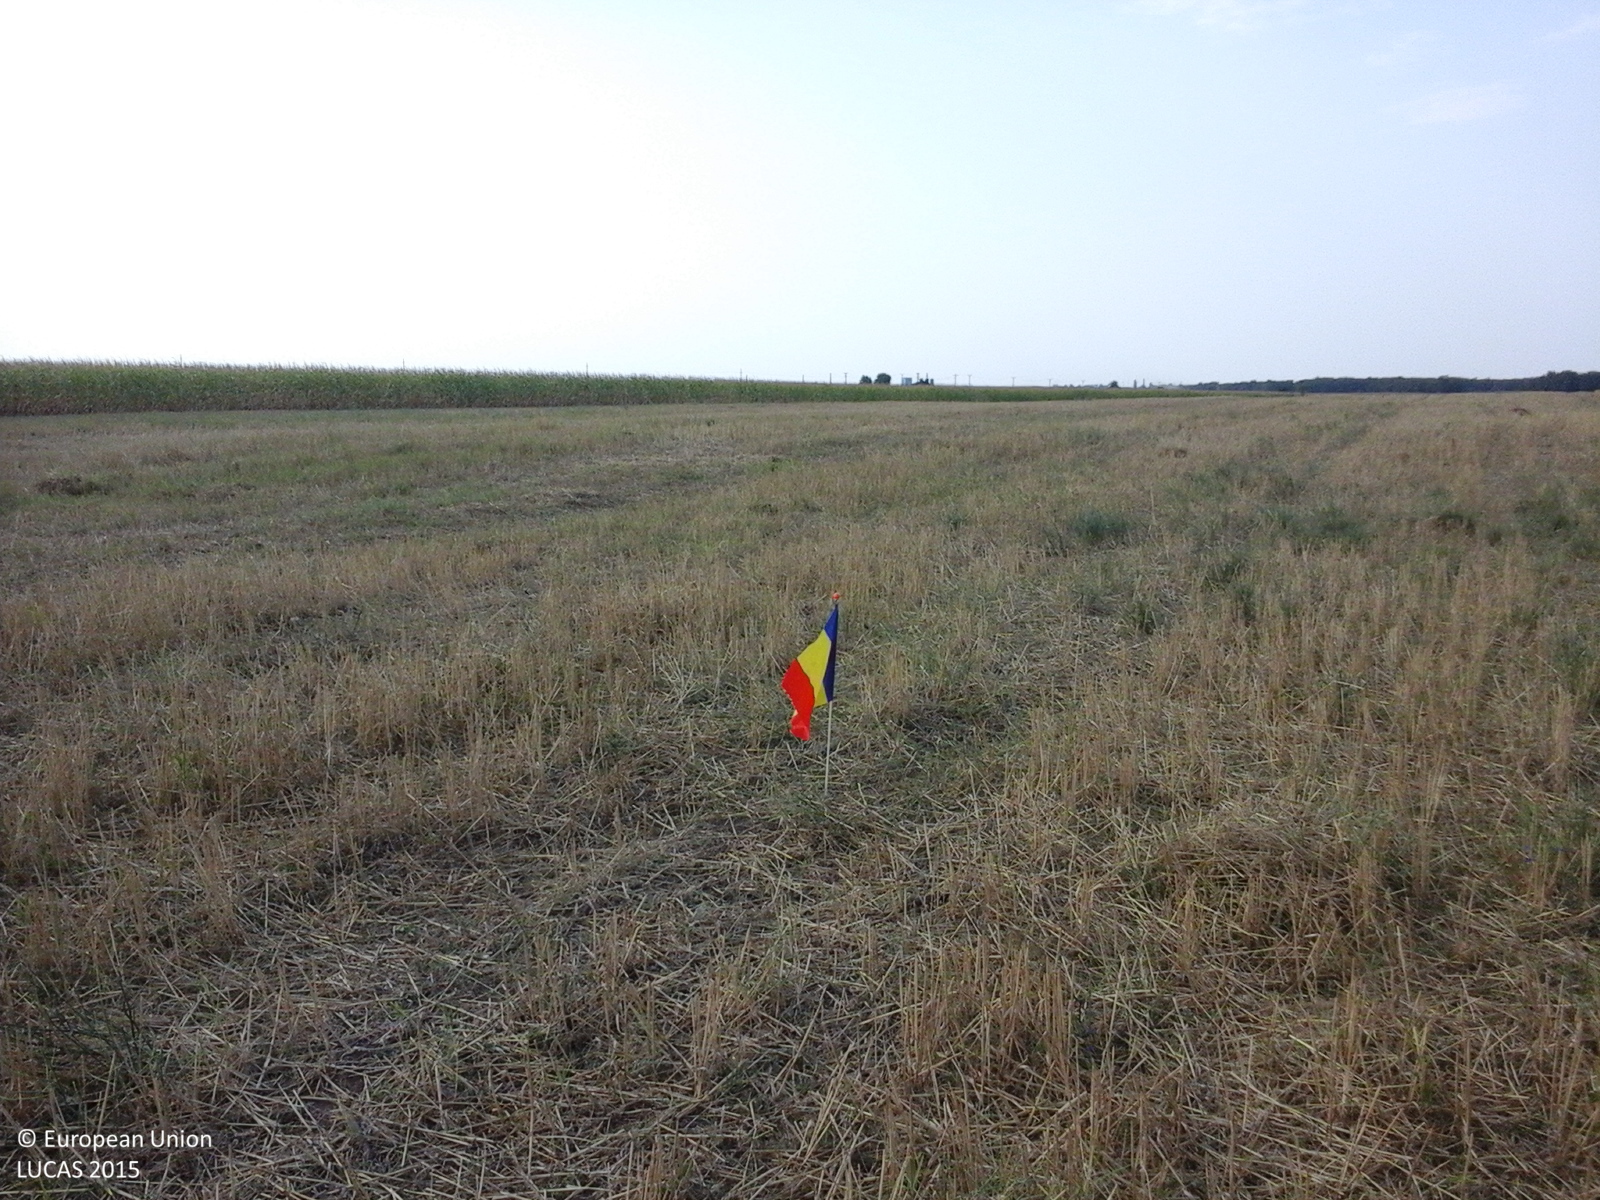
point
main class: Cropland
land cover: Barley
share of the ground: 50 - 75 %
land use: Agriculture (excluding fallow land and kitchen gardens)
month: August
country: RO
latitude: 45.2545
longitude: 27.5458
